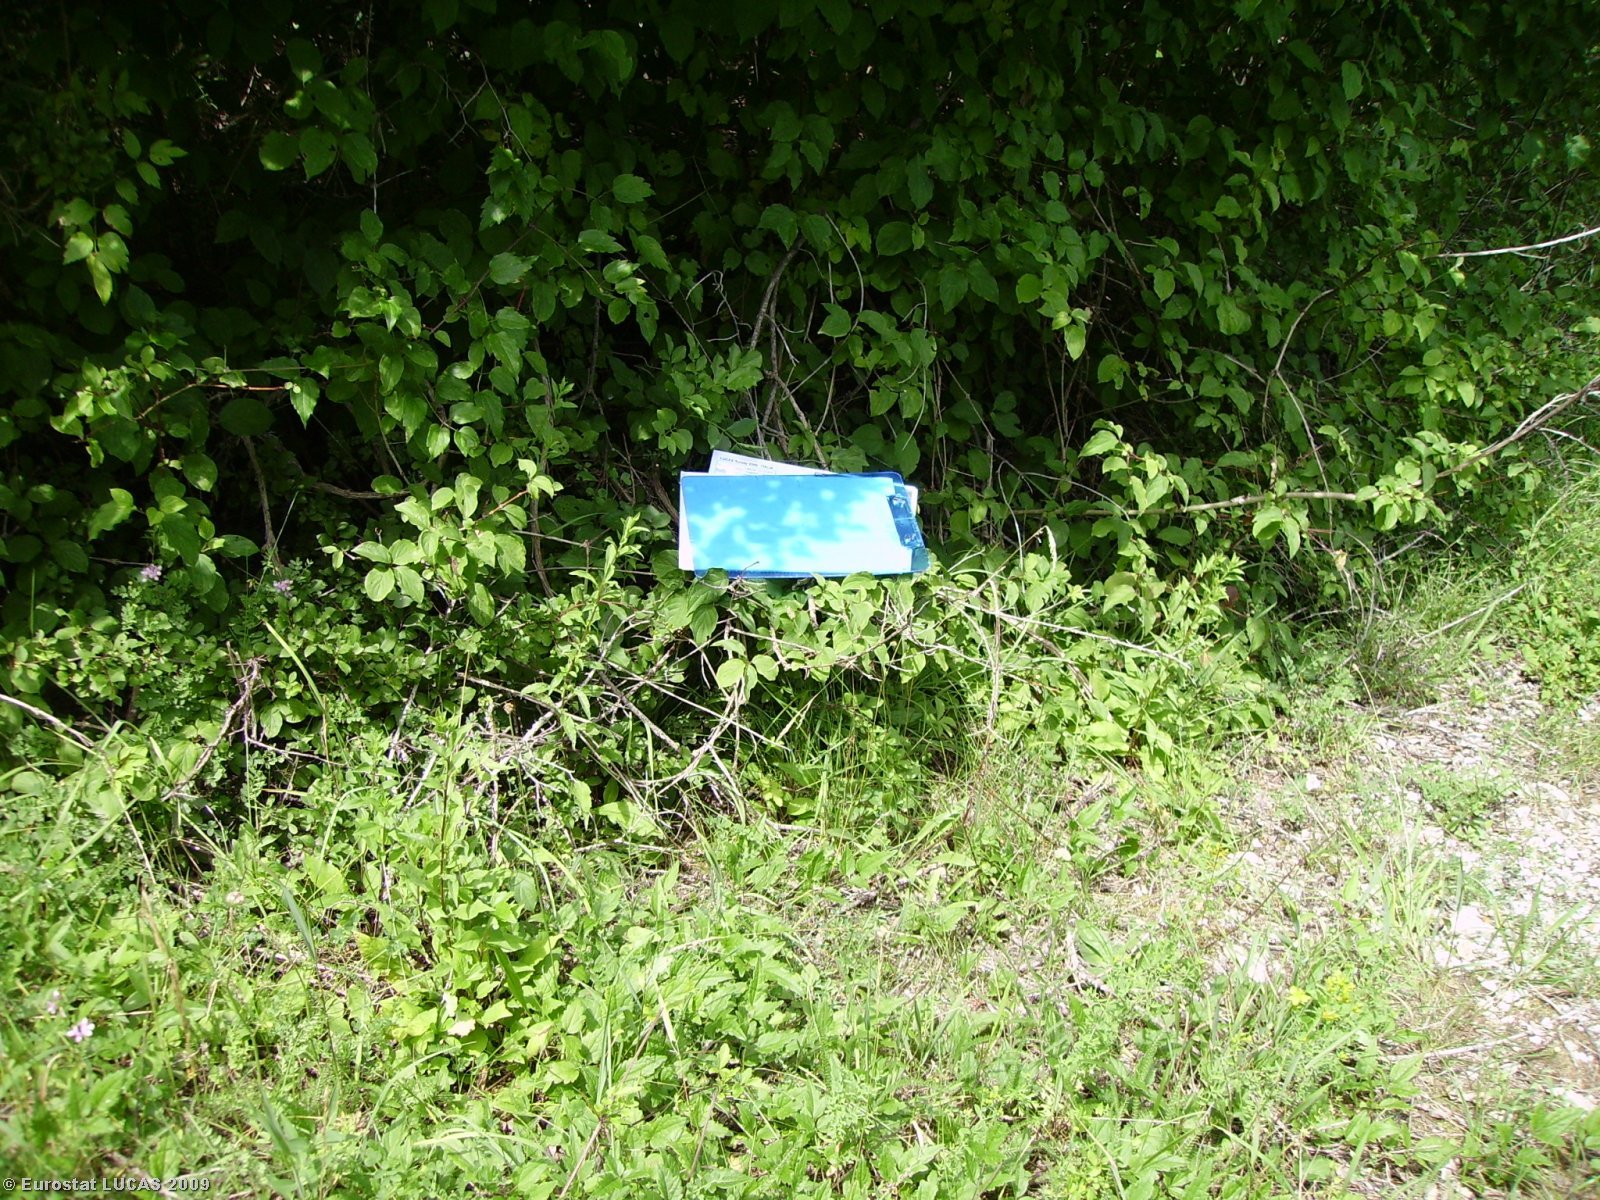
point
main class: Woodland
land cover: Broadleaved woodland
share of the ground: > 75 %
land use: Forestry
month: July
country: IT
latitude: 44.7268
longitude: 9.2818
